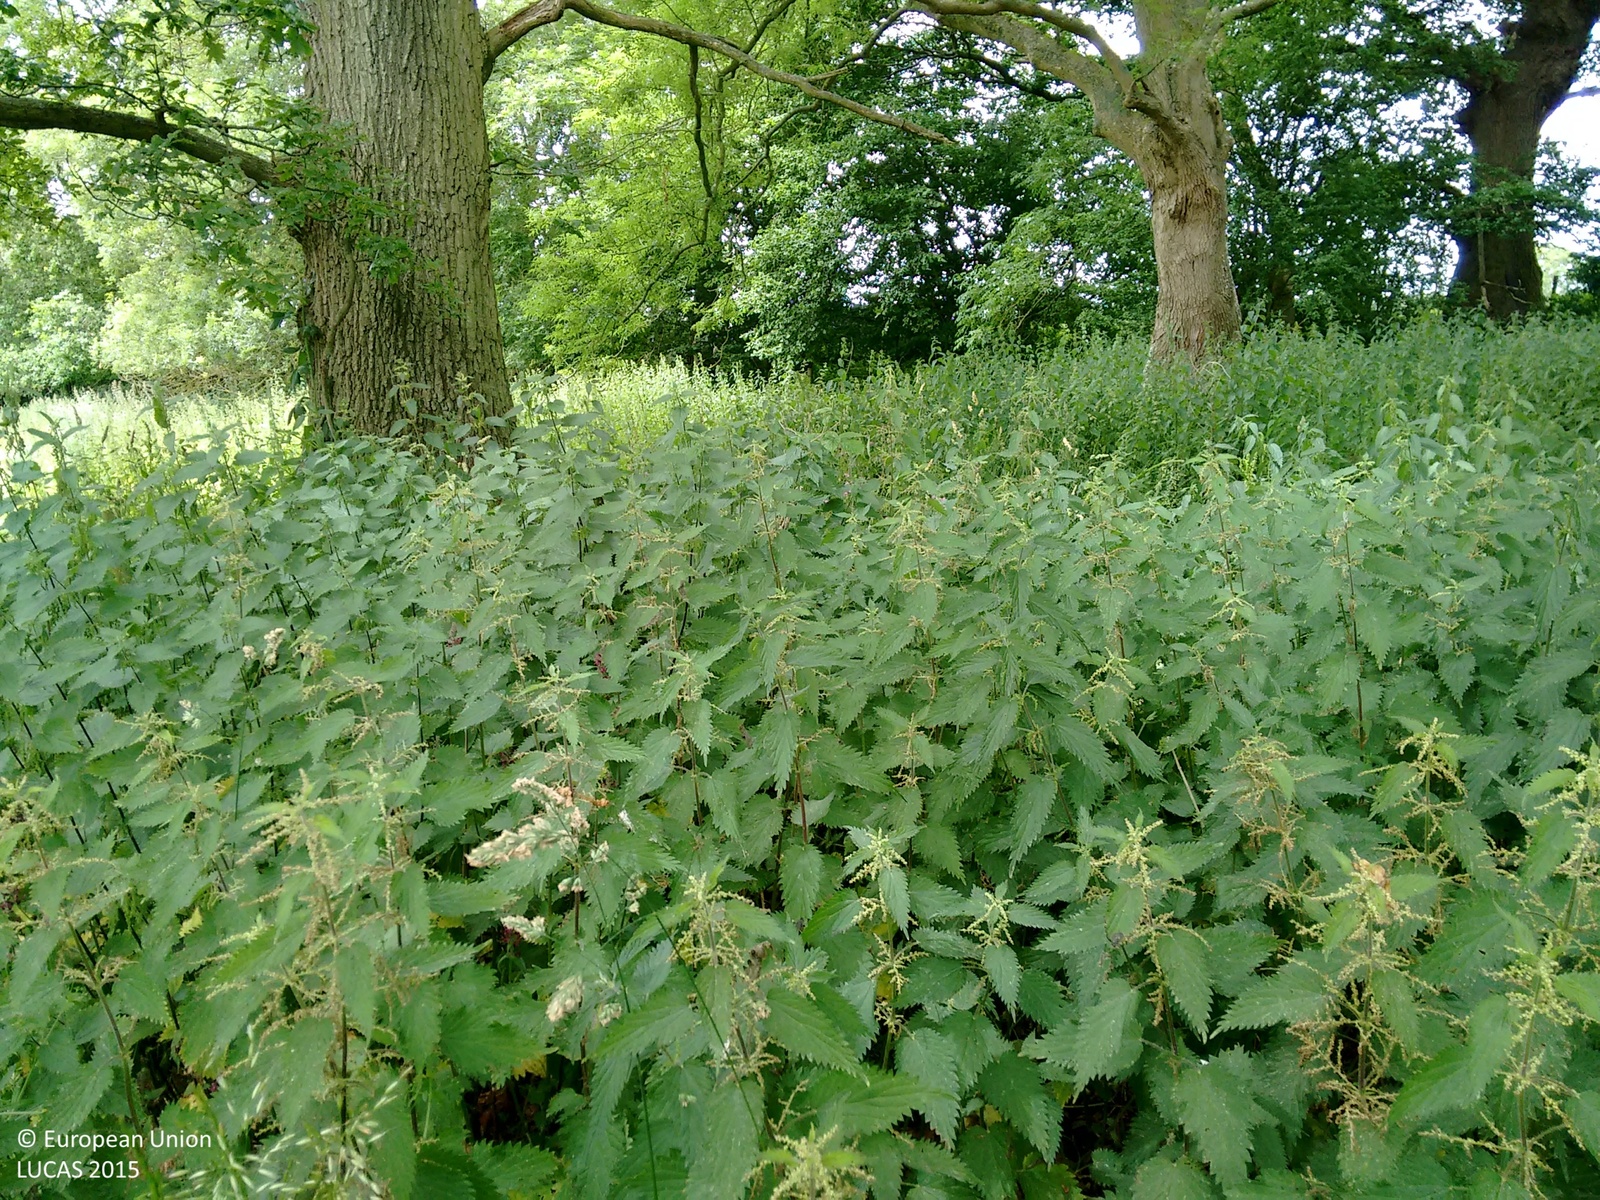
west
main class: Woodland
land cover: Broadleaved woodland
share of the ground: > 75 %
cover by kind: broadleaved forest trees 95 %, shrubs 5 %
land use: Agriculture (excluding fallow land and kitchen gardens)
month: June
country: GB
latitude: 52.3225
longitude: -2.7618
